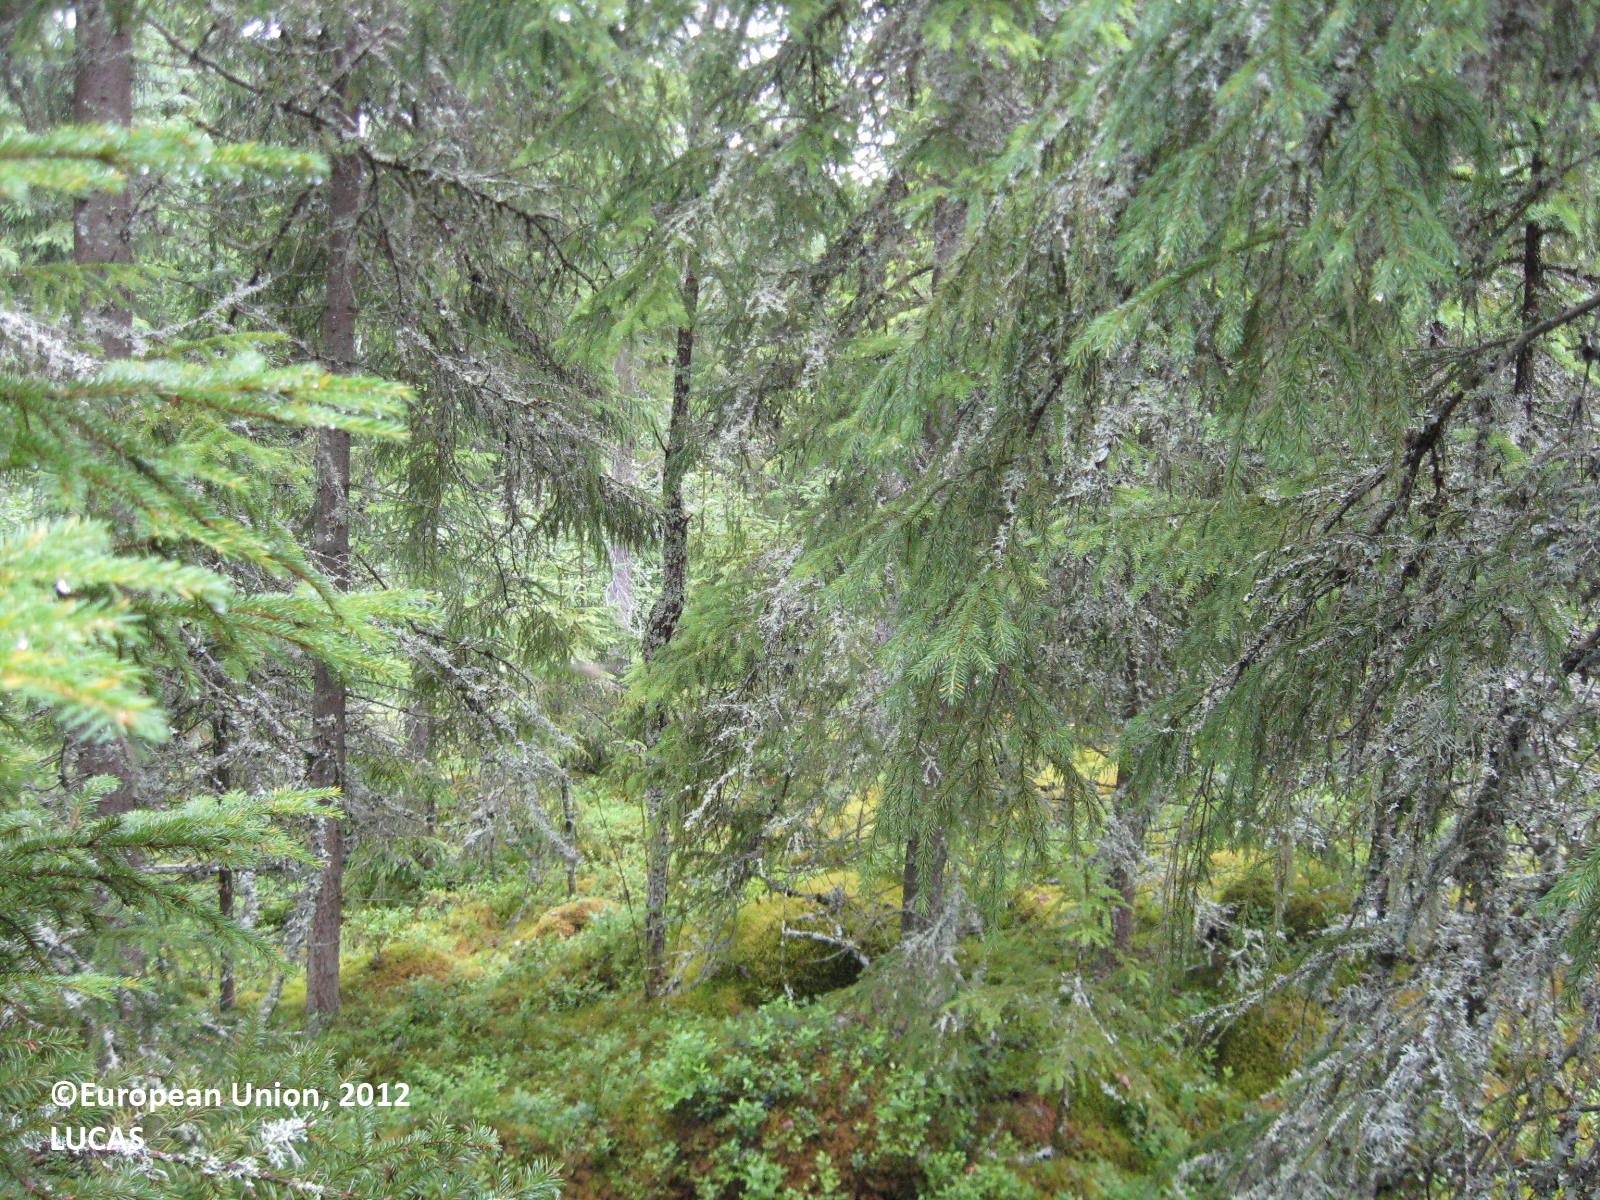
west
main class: Woodland
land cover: Pine dominated coniferous woodland
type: boreal forest
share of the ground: > 75 %
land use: Forestry
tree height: > 5 m
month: July
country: FI
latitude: 62.3425
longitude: 22.7477
